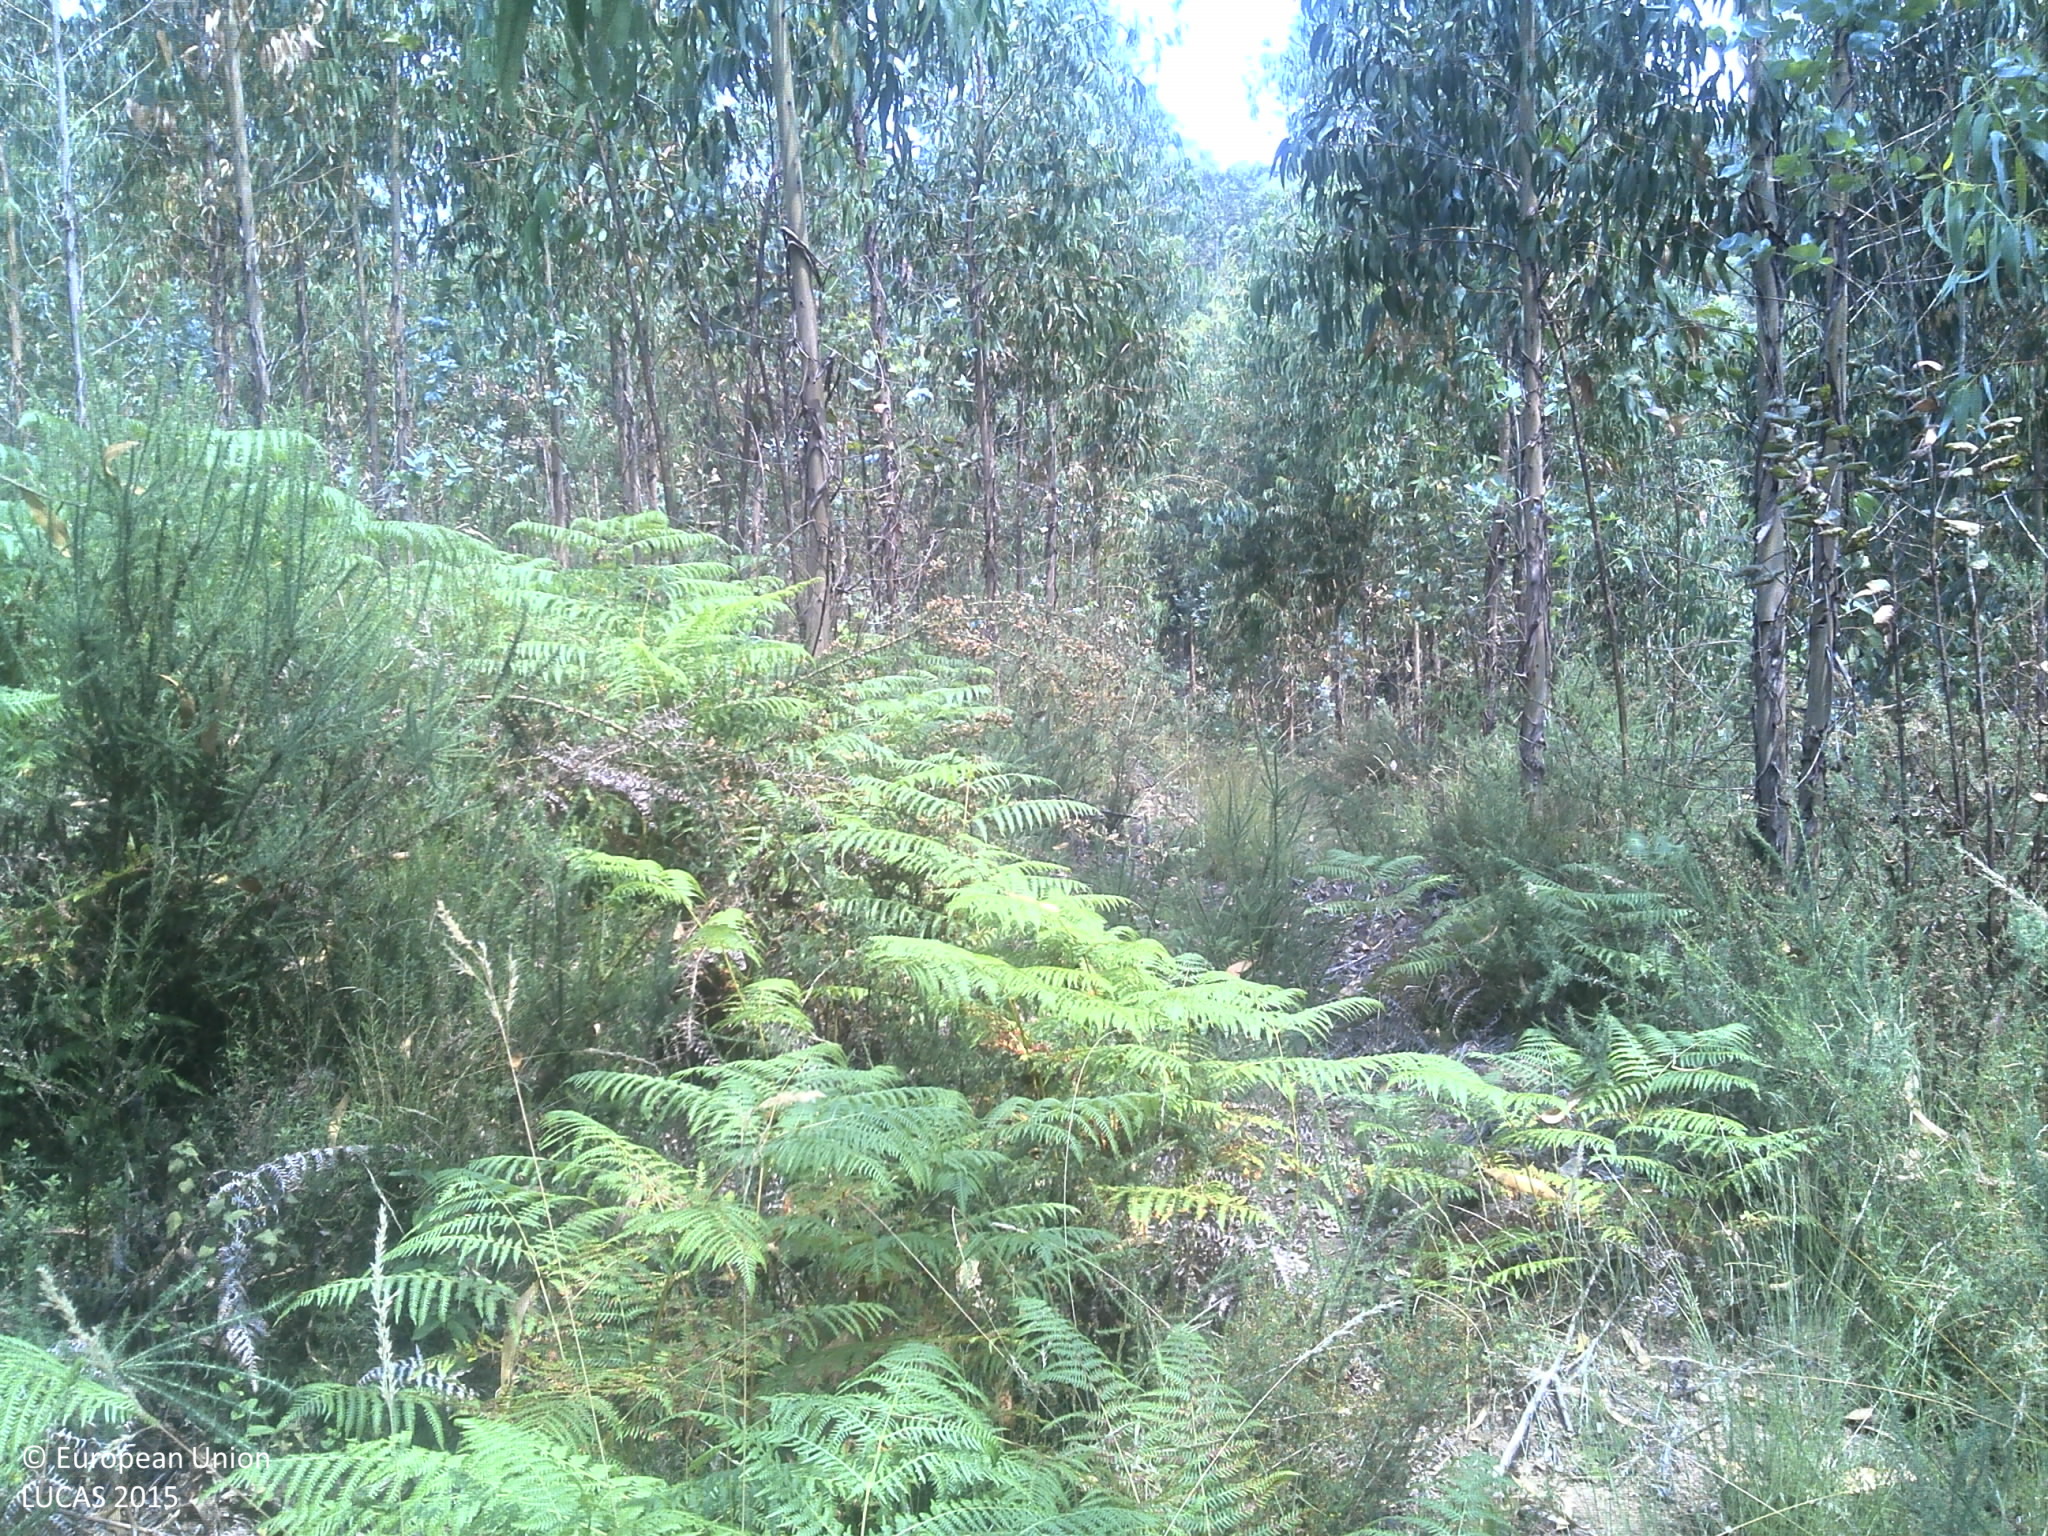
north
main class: Woodland
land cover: Broadleaved woodland
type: exotic forest
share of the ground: 50 - 75 %
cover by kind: broadleaved forest trees 60 %, shrubs 35 %, unconsolidated bare surface 5 %
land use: Forestry
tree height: > 5 m
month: June
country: PT
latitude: 41.3089
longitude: -8.2649
